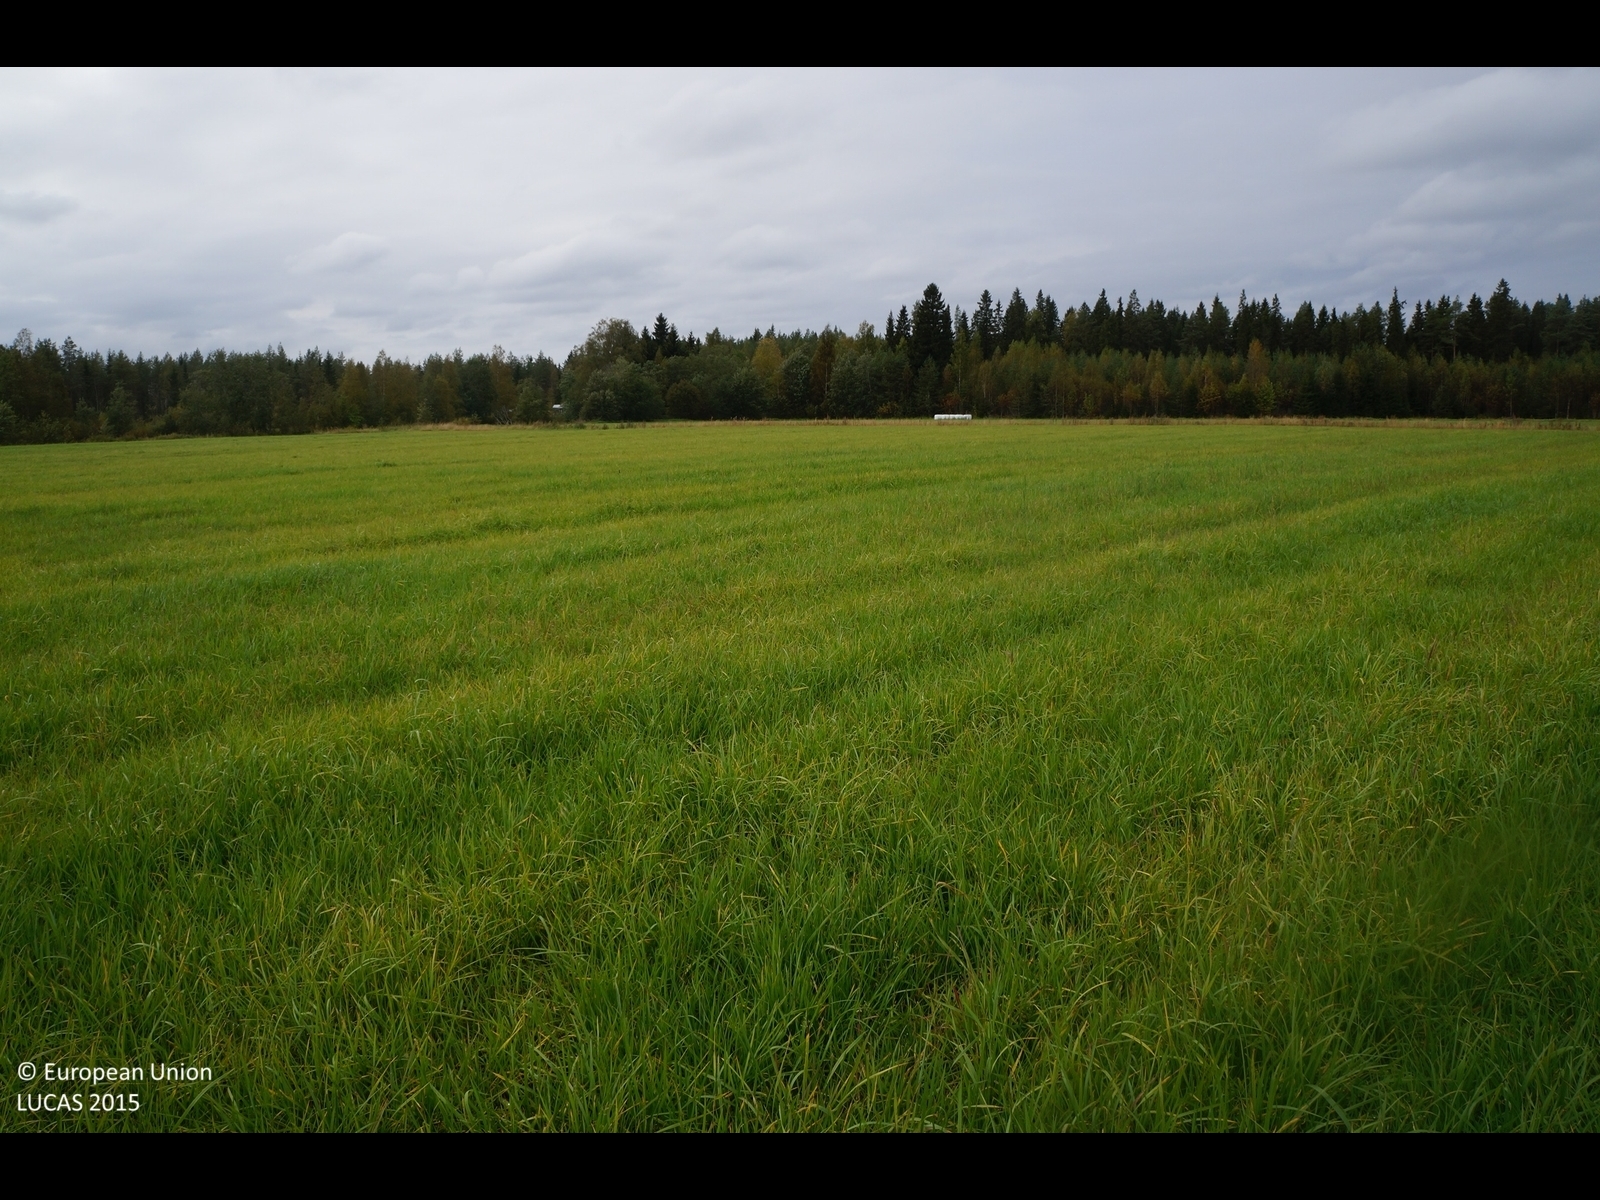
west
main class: Cropland
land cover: Temporary grasslands
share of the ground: > 75 %
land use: Agriculture (excluding fallow land and kitchen gardens)
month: September
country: FI
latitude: 63.9993
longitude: 23.7388
